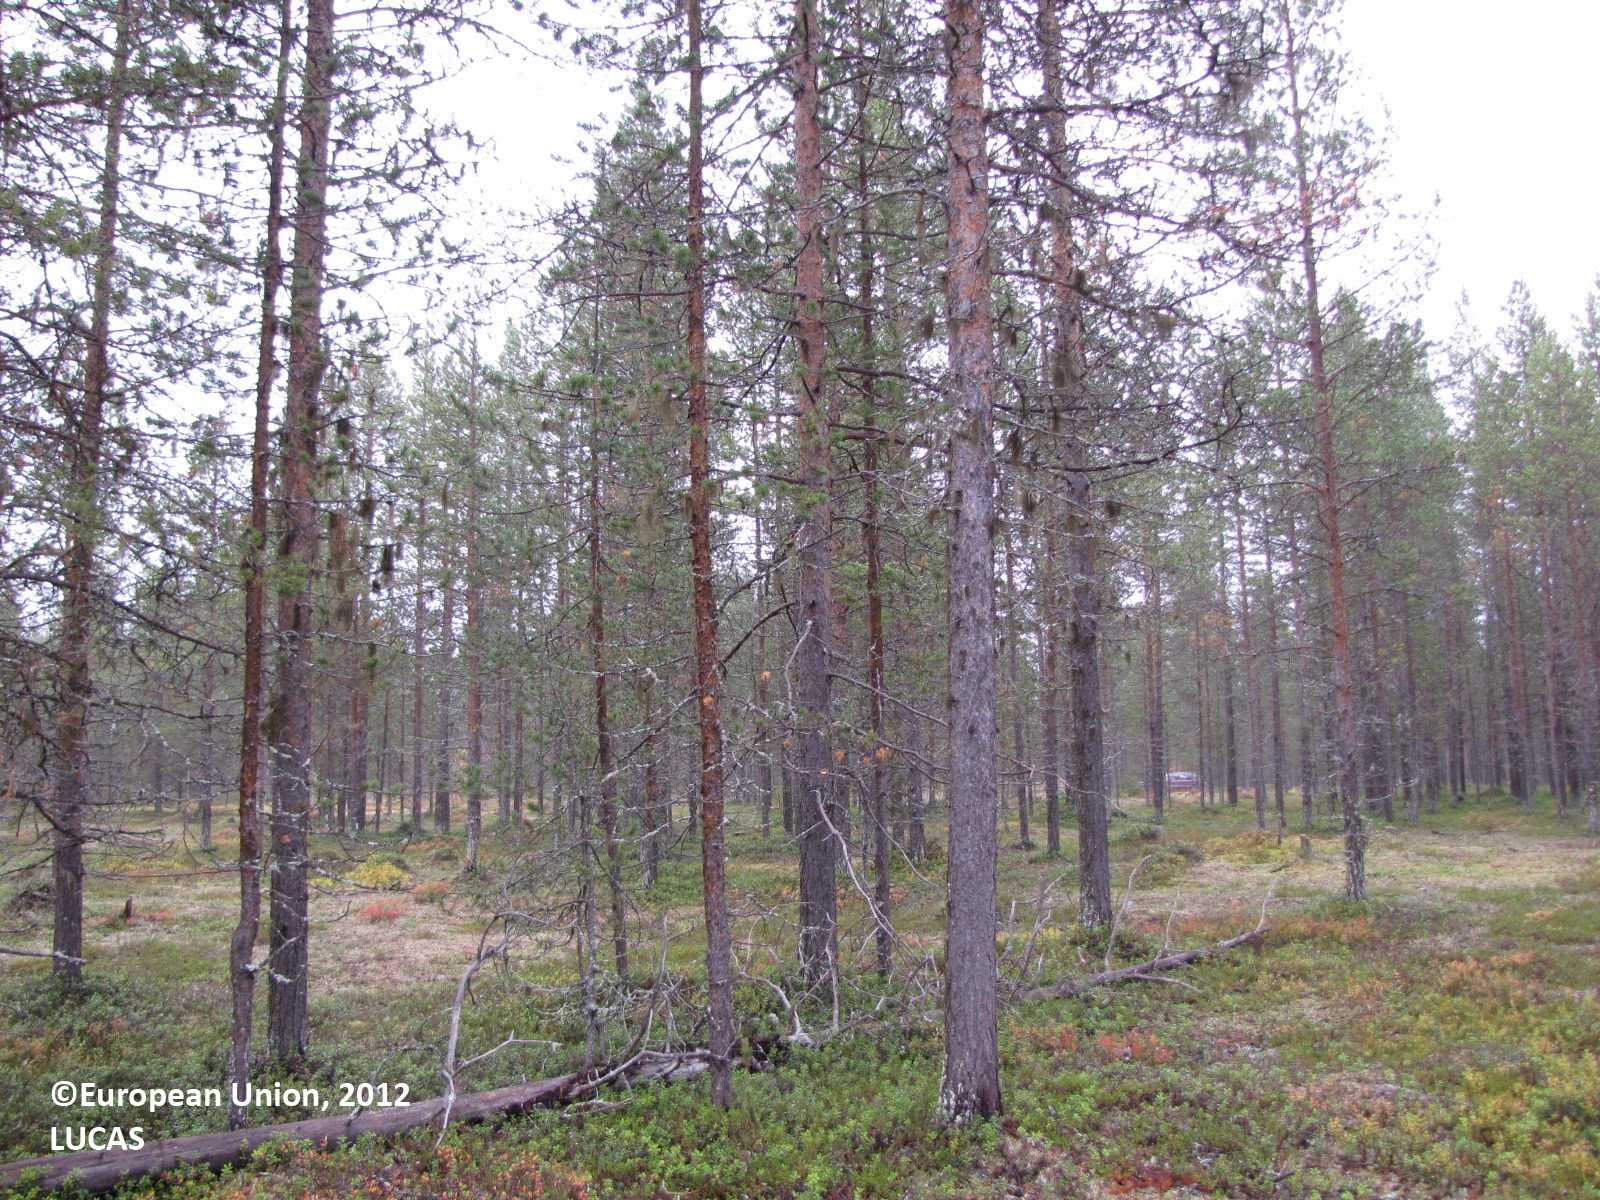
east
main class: Woodland
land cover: Pine dominated coniferous woodland
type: boreal forest
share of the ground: 25 - 50 %
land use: Forestry
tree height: > 5 m
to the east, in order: Pine dominated coniferous woodland; Paved roads, cycling and walking lanes; Ditches and canals; Pine dominated coniferous woodland; Pine dominated mixed woodland; Ditches and canals; Pine dominated mixed woodland
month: September
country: FI
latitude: 67.4132
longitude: 24.1416
